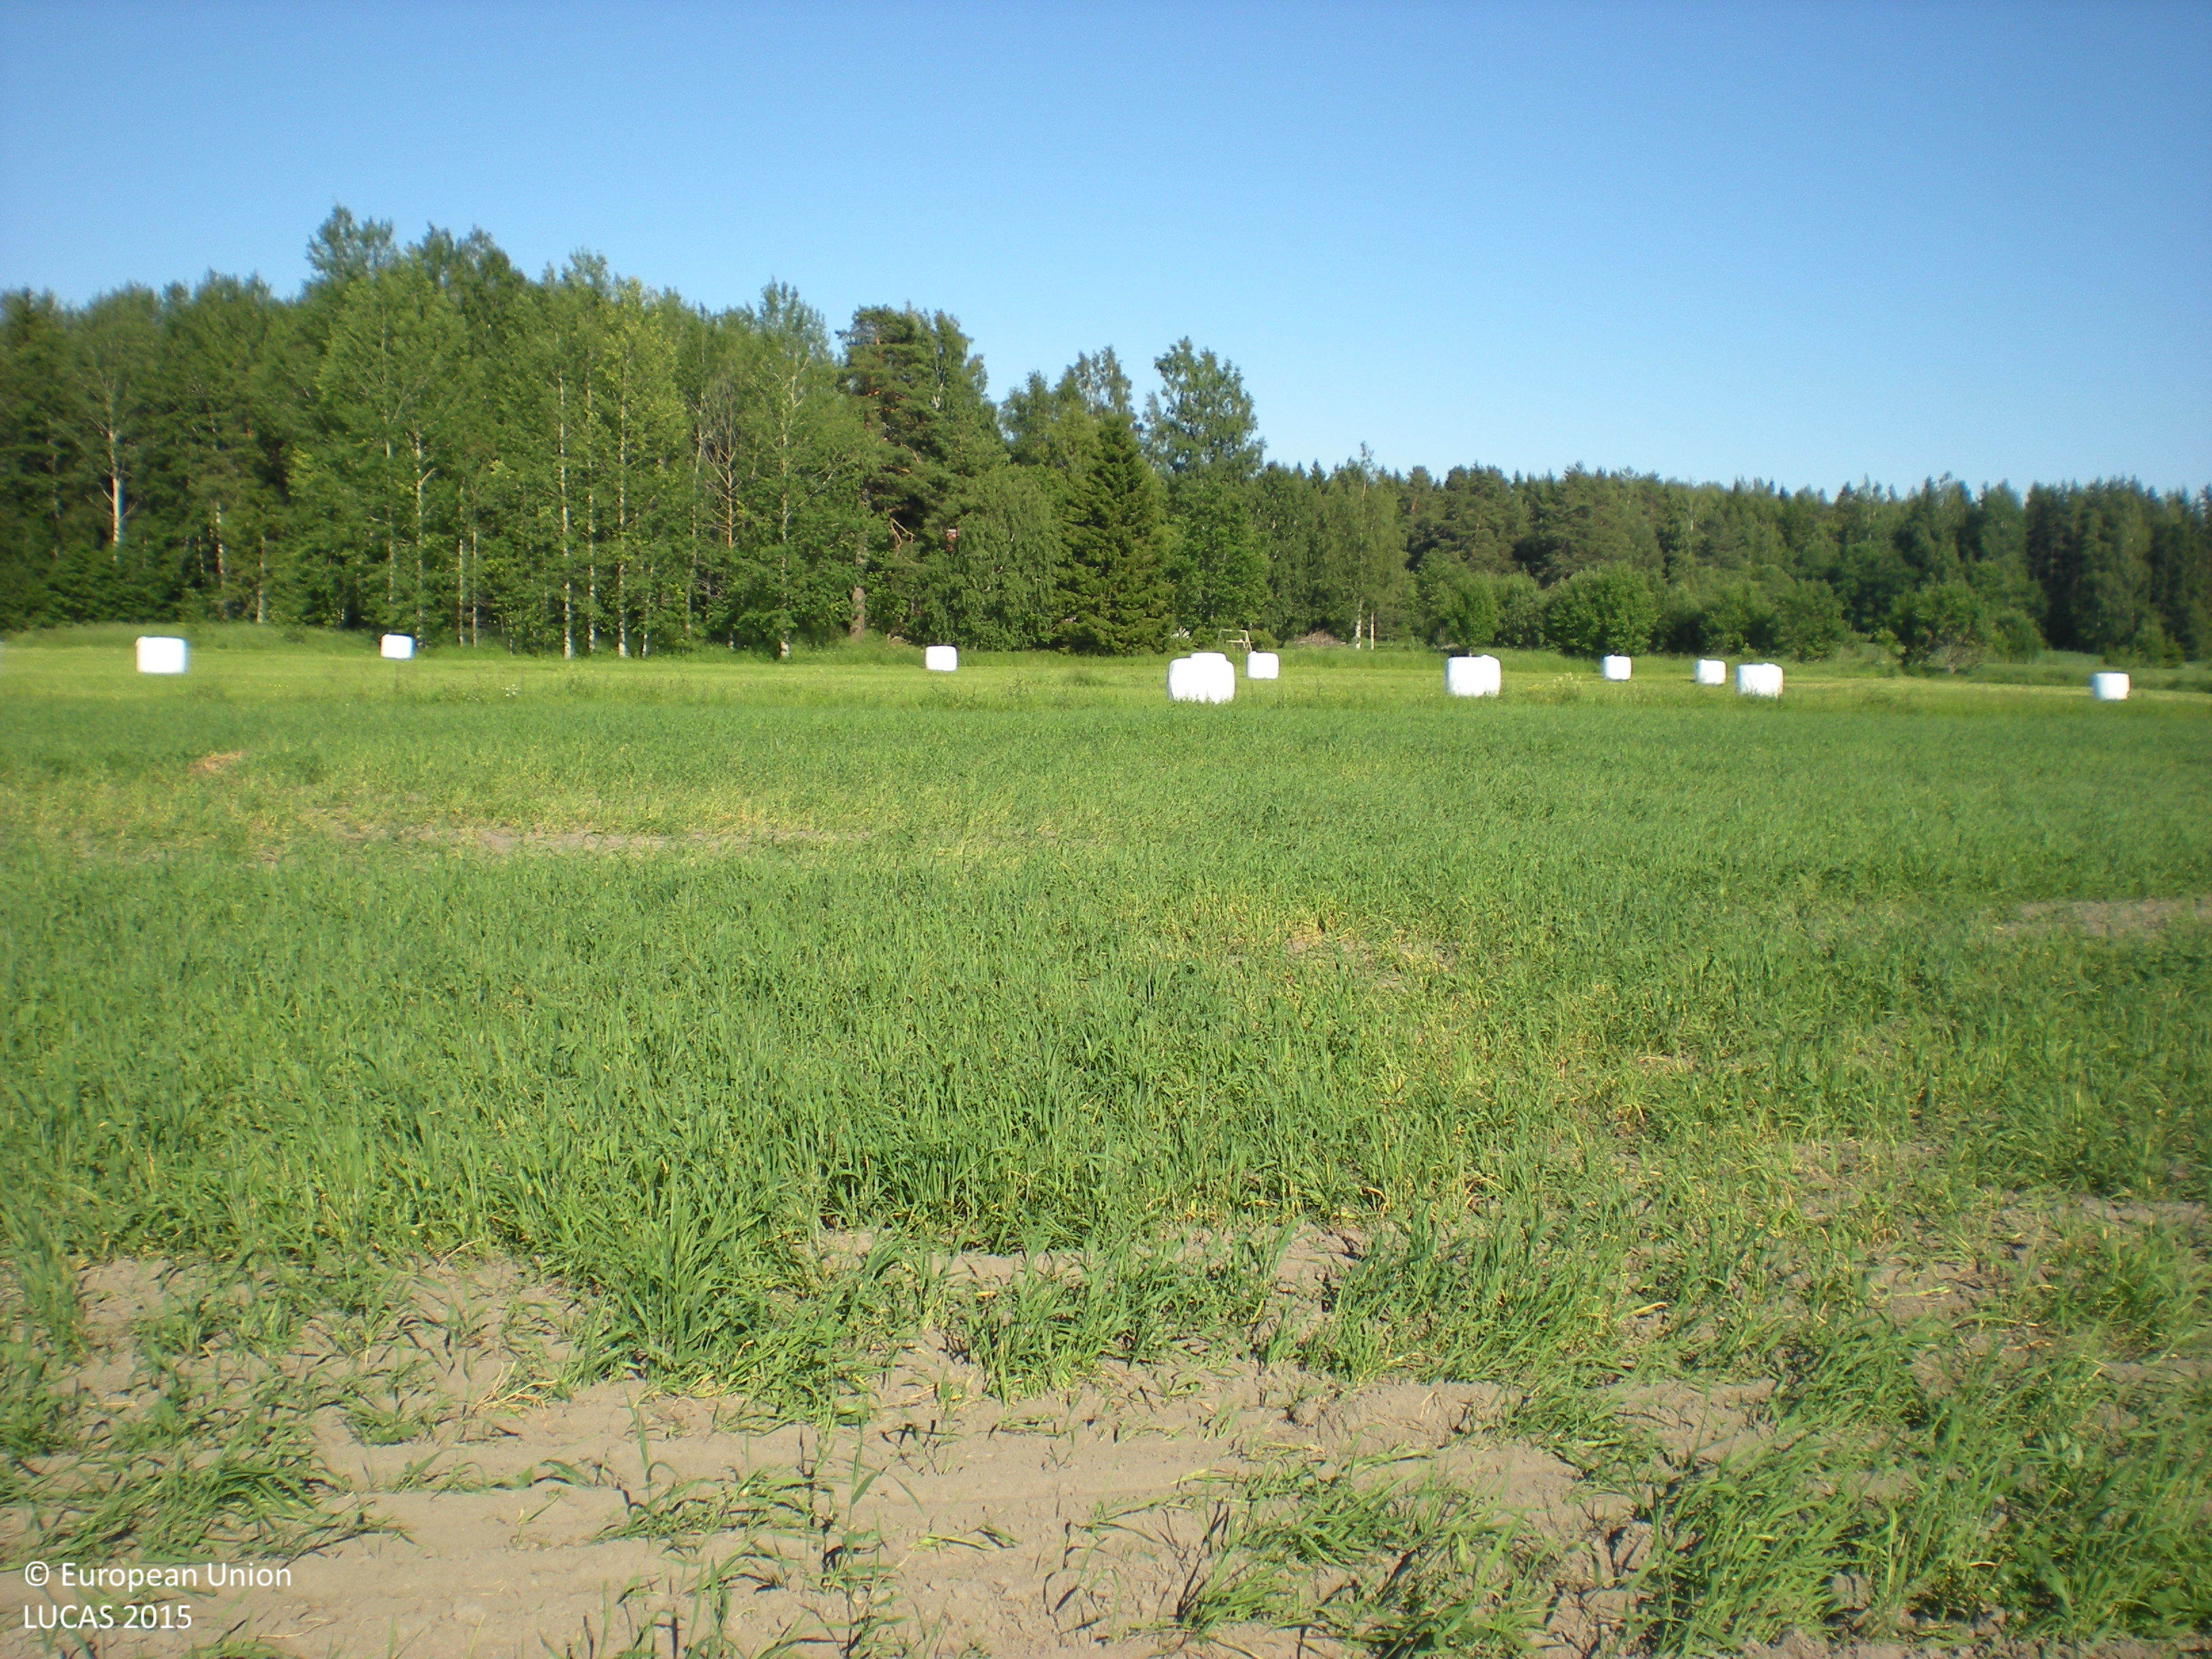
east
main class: Cropland
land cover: Barley
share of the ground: 50 - 75 %
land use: Agriculture (excluding fallow land and kitchen gardens)
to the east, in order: Barley; Grass margins; Ditches and canals; Grass margins; Temporary grasslands; Ditches and canals; Broadleaved woodland; Artificial constructions in urban areas; Broadleaved woodland; Other mixed woodland; Shrubland with sparse tree cover; Rye
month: July
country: SE
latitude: 60.4757
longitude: 17.7233
